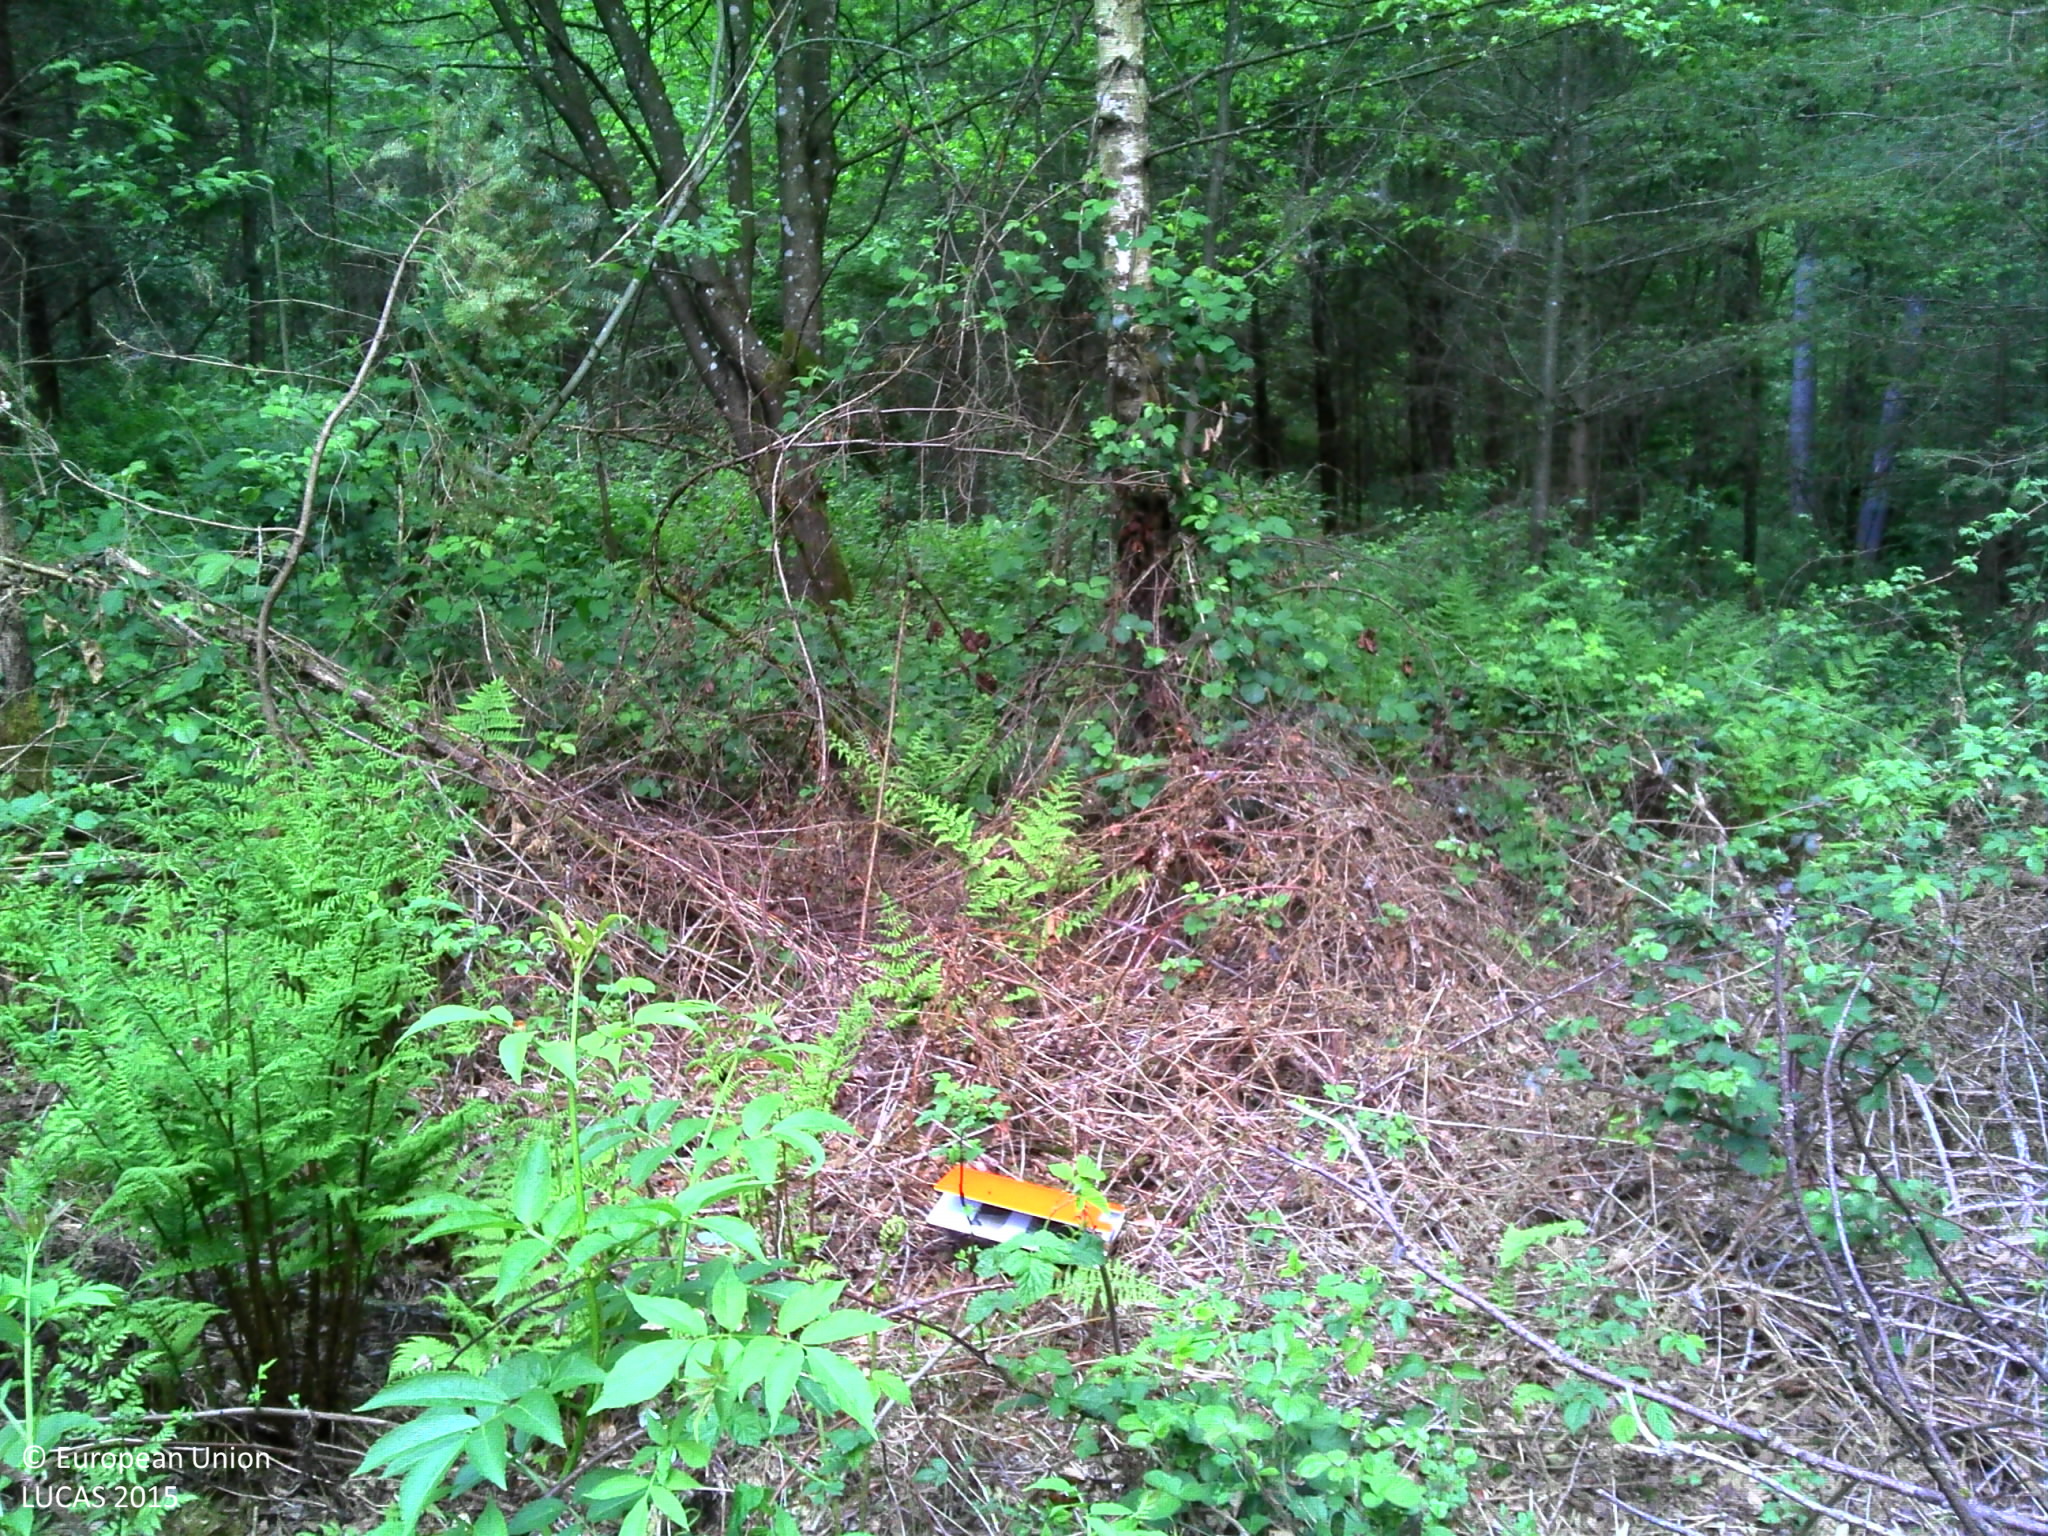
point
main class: Woodland
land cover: Other mixed woodland
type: hemiboreal forest and nemoral coniferous forest and mixed broadleaved-coniferous forest
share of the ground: > 75 %
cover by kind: broadleaved forest trees 60 %, coniferous forest trees 40 %
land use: Forestry
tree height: > 5 m
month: May
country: LU
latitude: 49.6827
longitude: 6.0215
